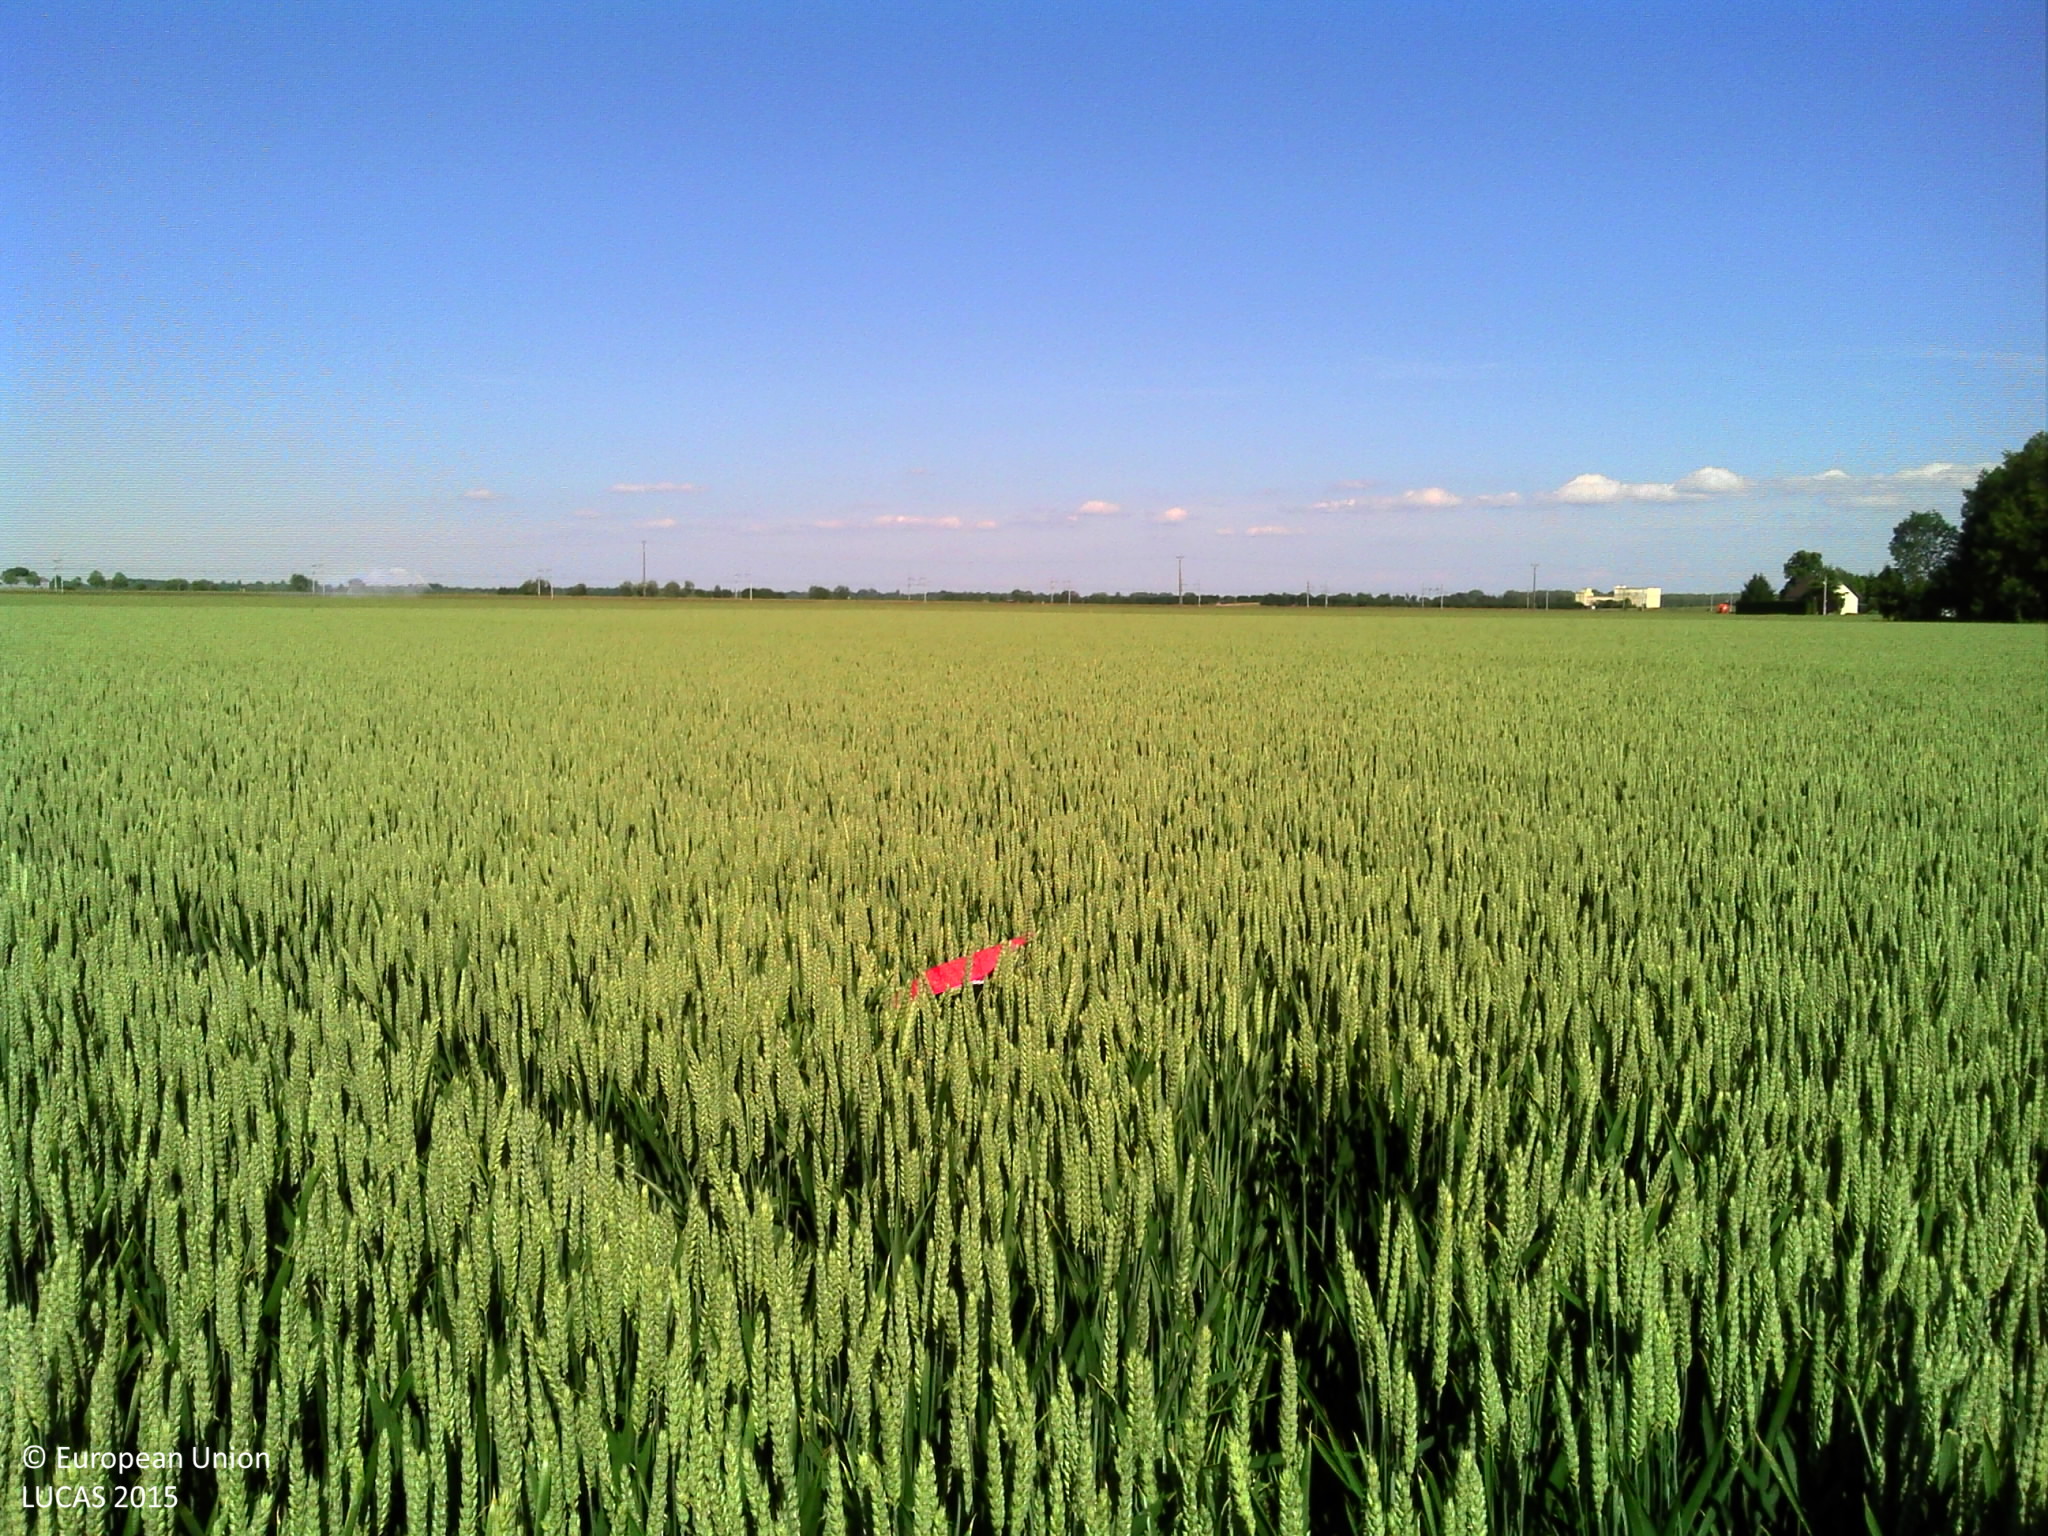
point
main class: Cropland
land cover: Common wheat
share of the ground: > 75 %
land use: Agriculture (excluding fallow land and kitchen gardens)
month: June
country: FR
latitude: 47.2479
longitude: 5.0725
